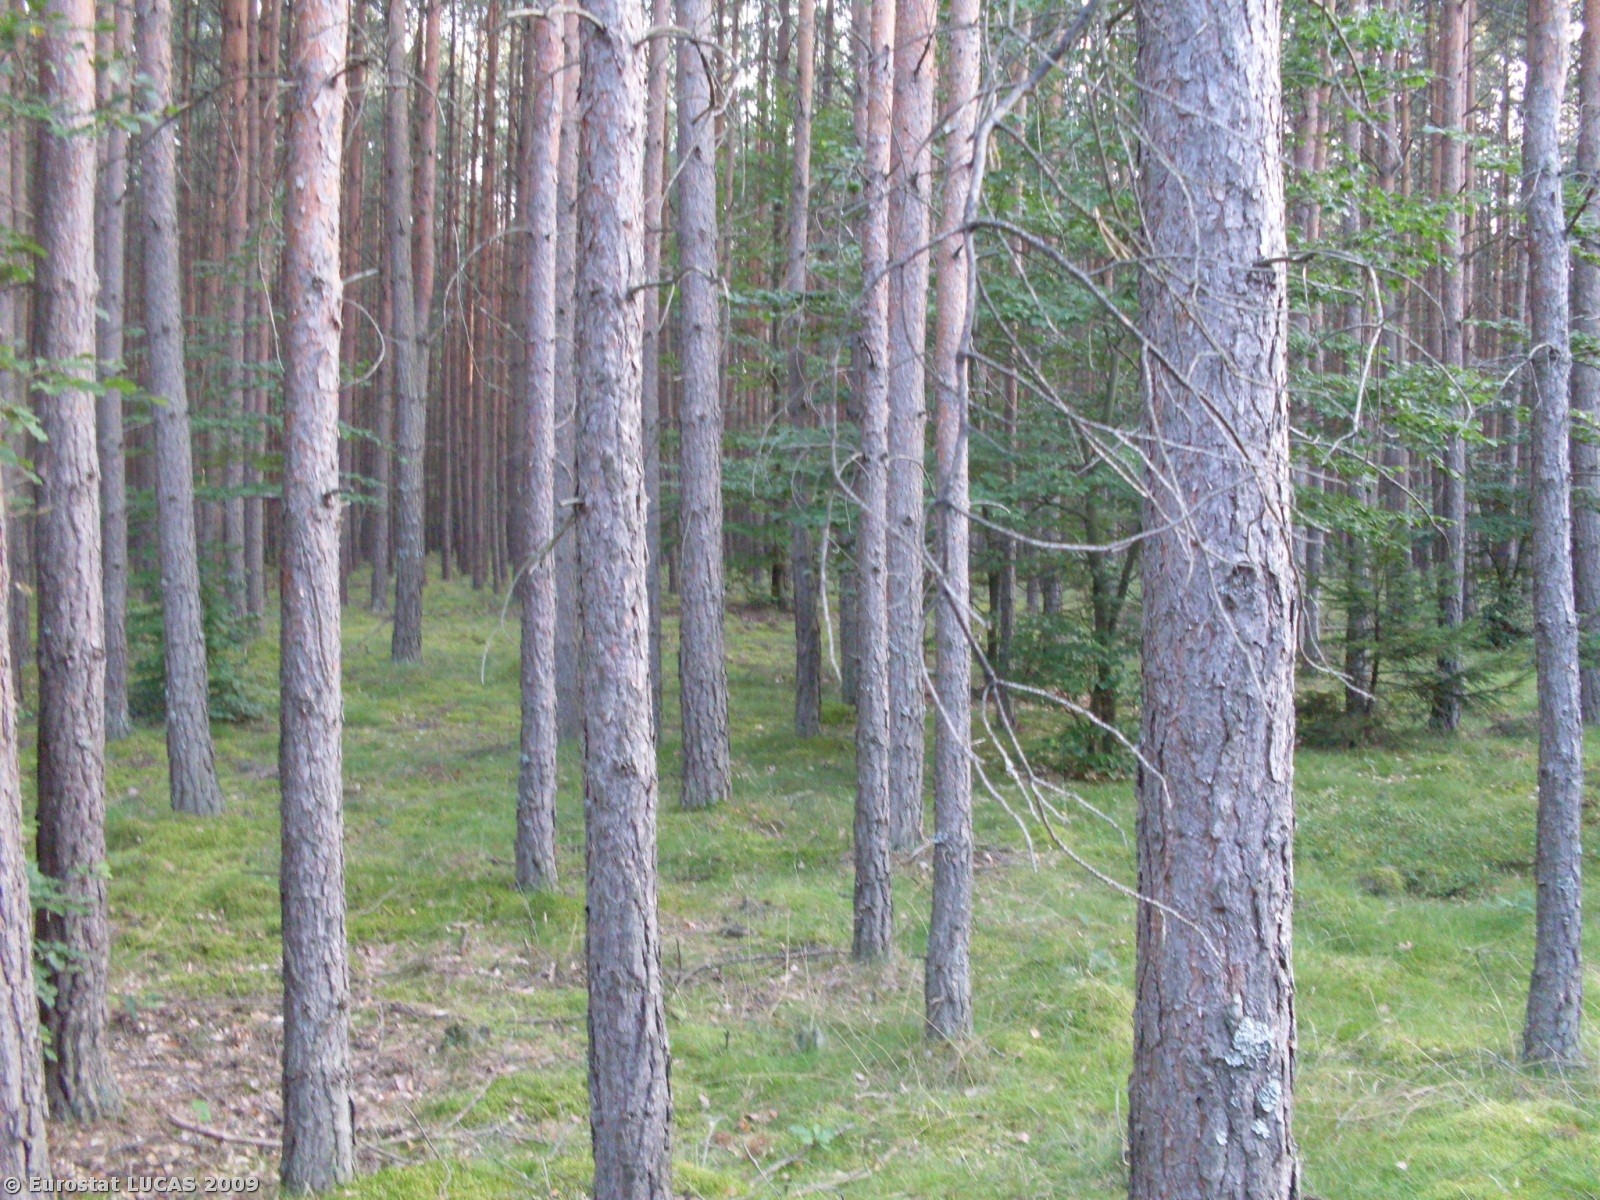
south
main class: Woodland
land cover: Coniferous woodland
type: hemiboreal forest and nemoral coniferous forest and mixed broadleaved-coniferous forest
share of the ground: > 75 %
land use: Forestry
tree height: > 5 m
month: August
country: PL
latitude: 53.0943
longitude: 15.9334
